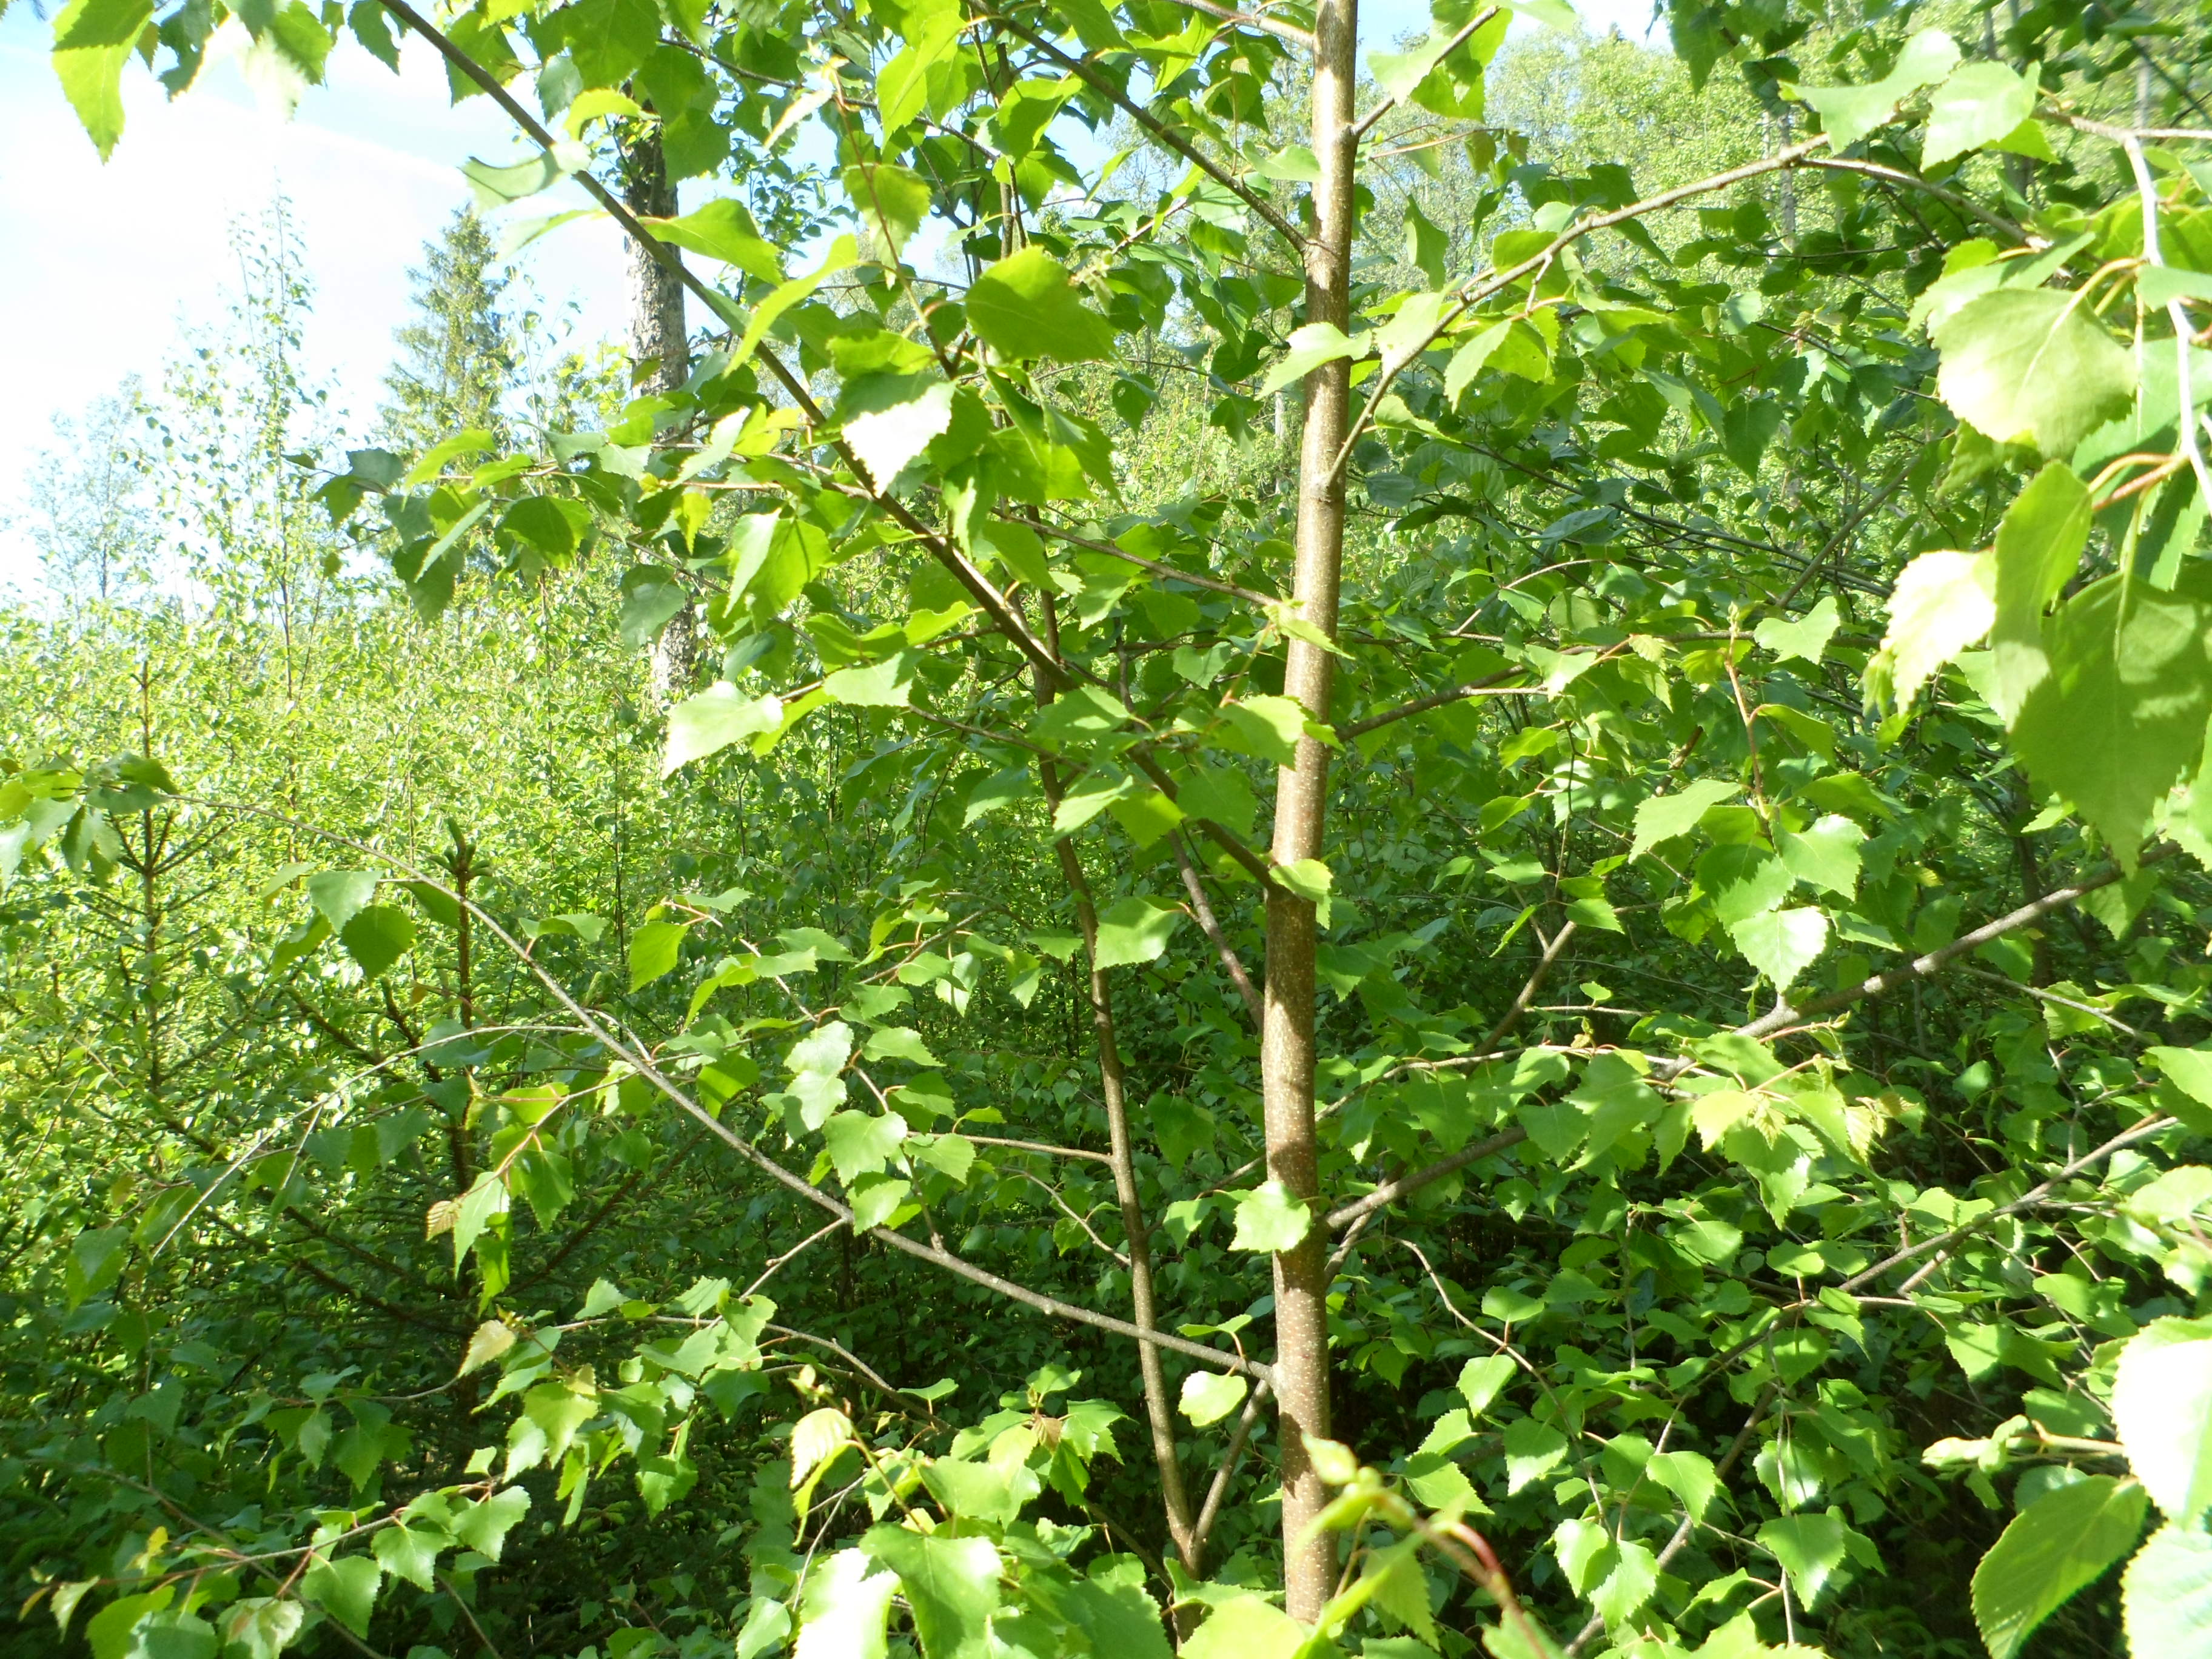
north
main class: Woodland
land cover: Broadleaved woodland
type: boreal forest
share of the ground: > 75 %
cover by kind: broadleaved forest trees 90 %, herbaceous plants 5 %, unconsolidated bare surface 5 %
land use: Forestry
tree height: < 5 m
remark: Clear cut
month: June
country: SE
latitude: 56.9955
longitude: 14.8858
